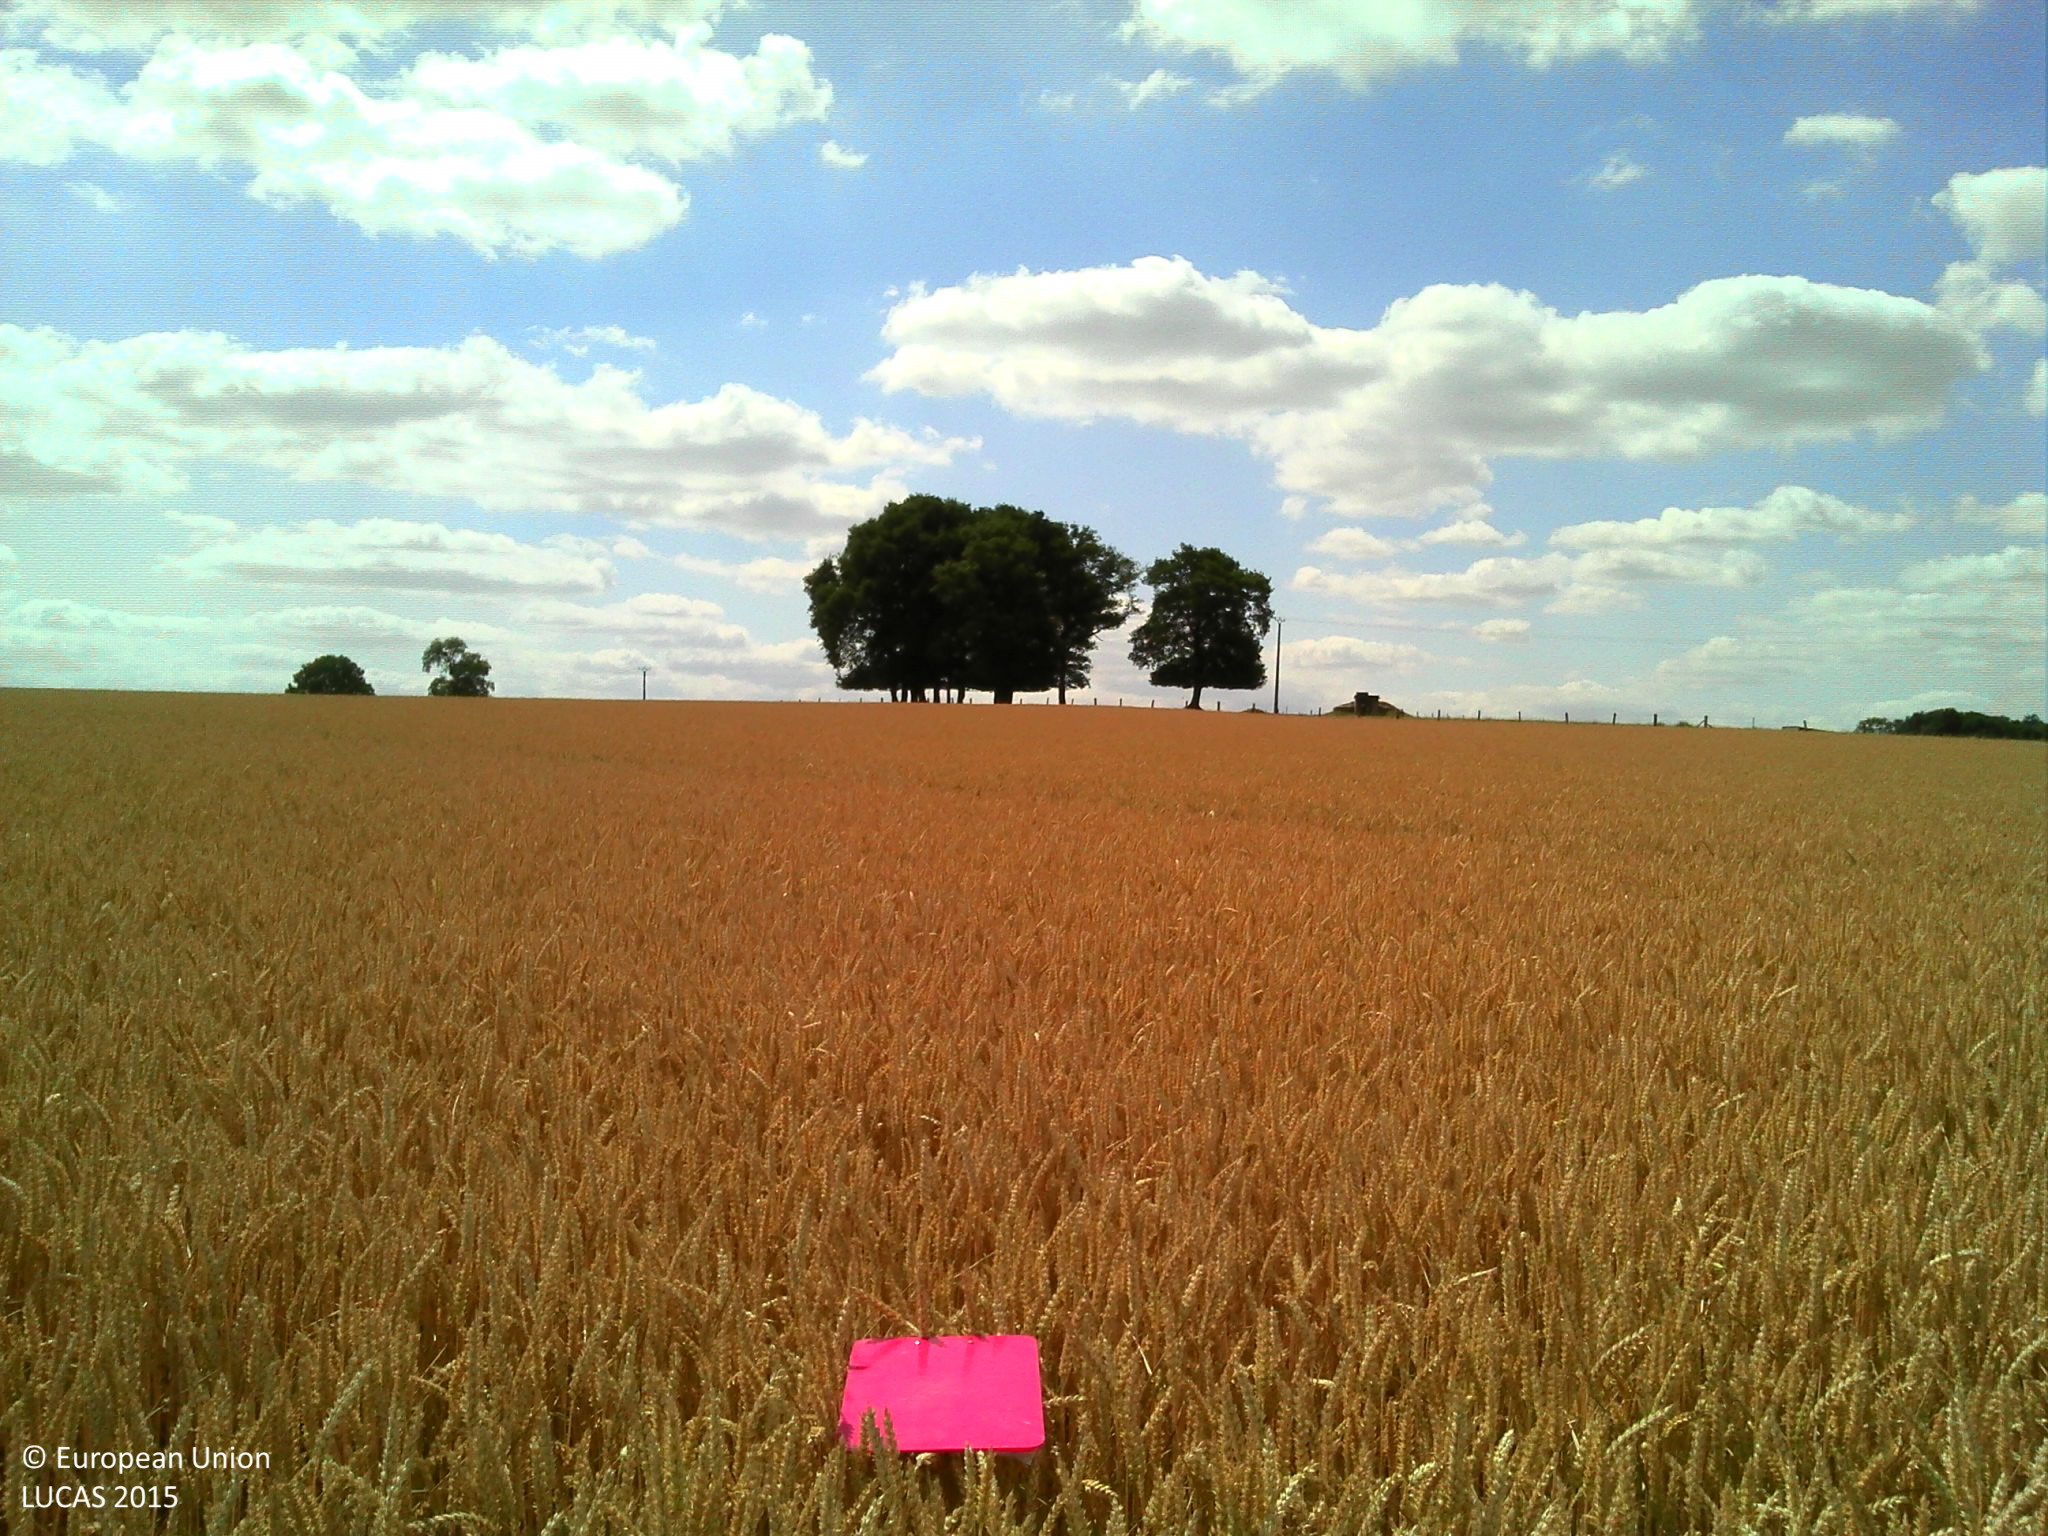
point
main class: Cropland
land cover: Common wheat
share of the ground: > 75 %
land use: Agriculture (excluding fallow land and kitchen gardens)
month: July
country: FR
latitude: 49.3299
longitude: 1.8242
